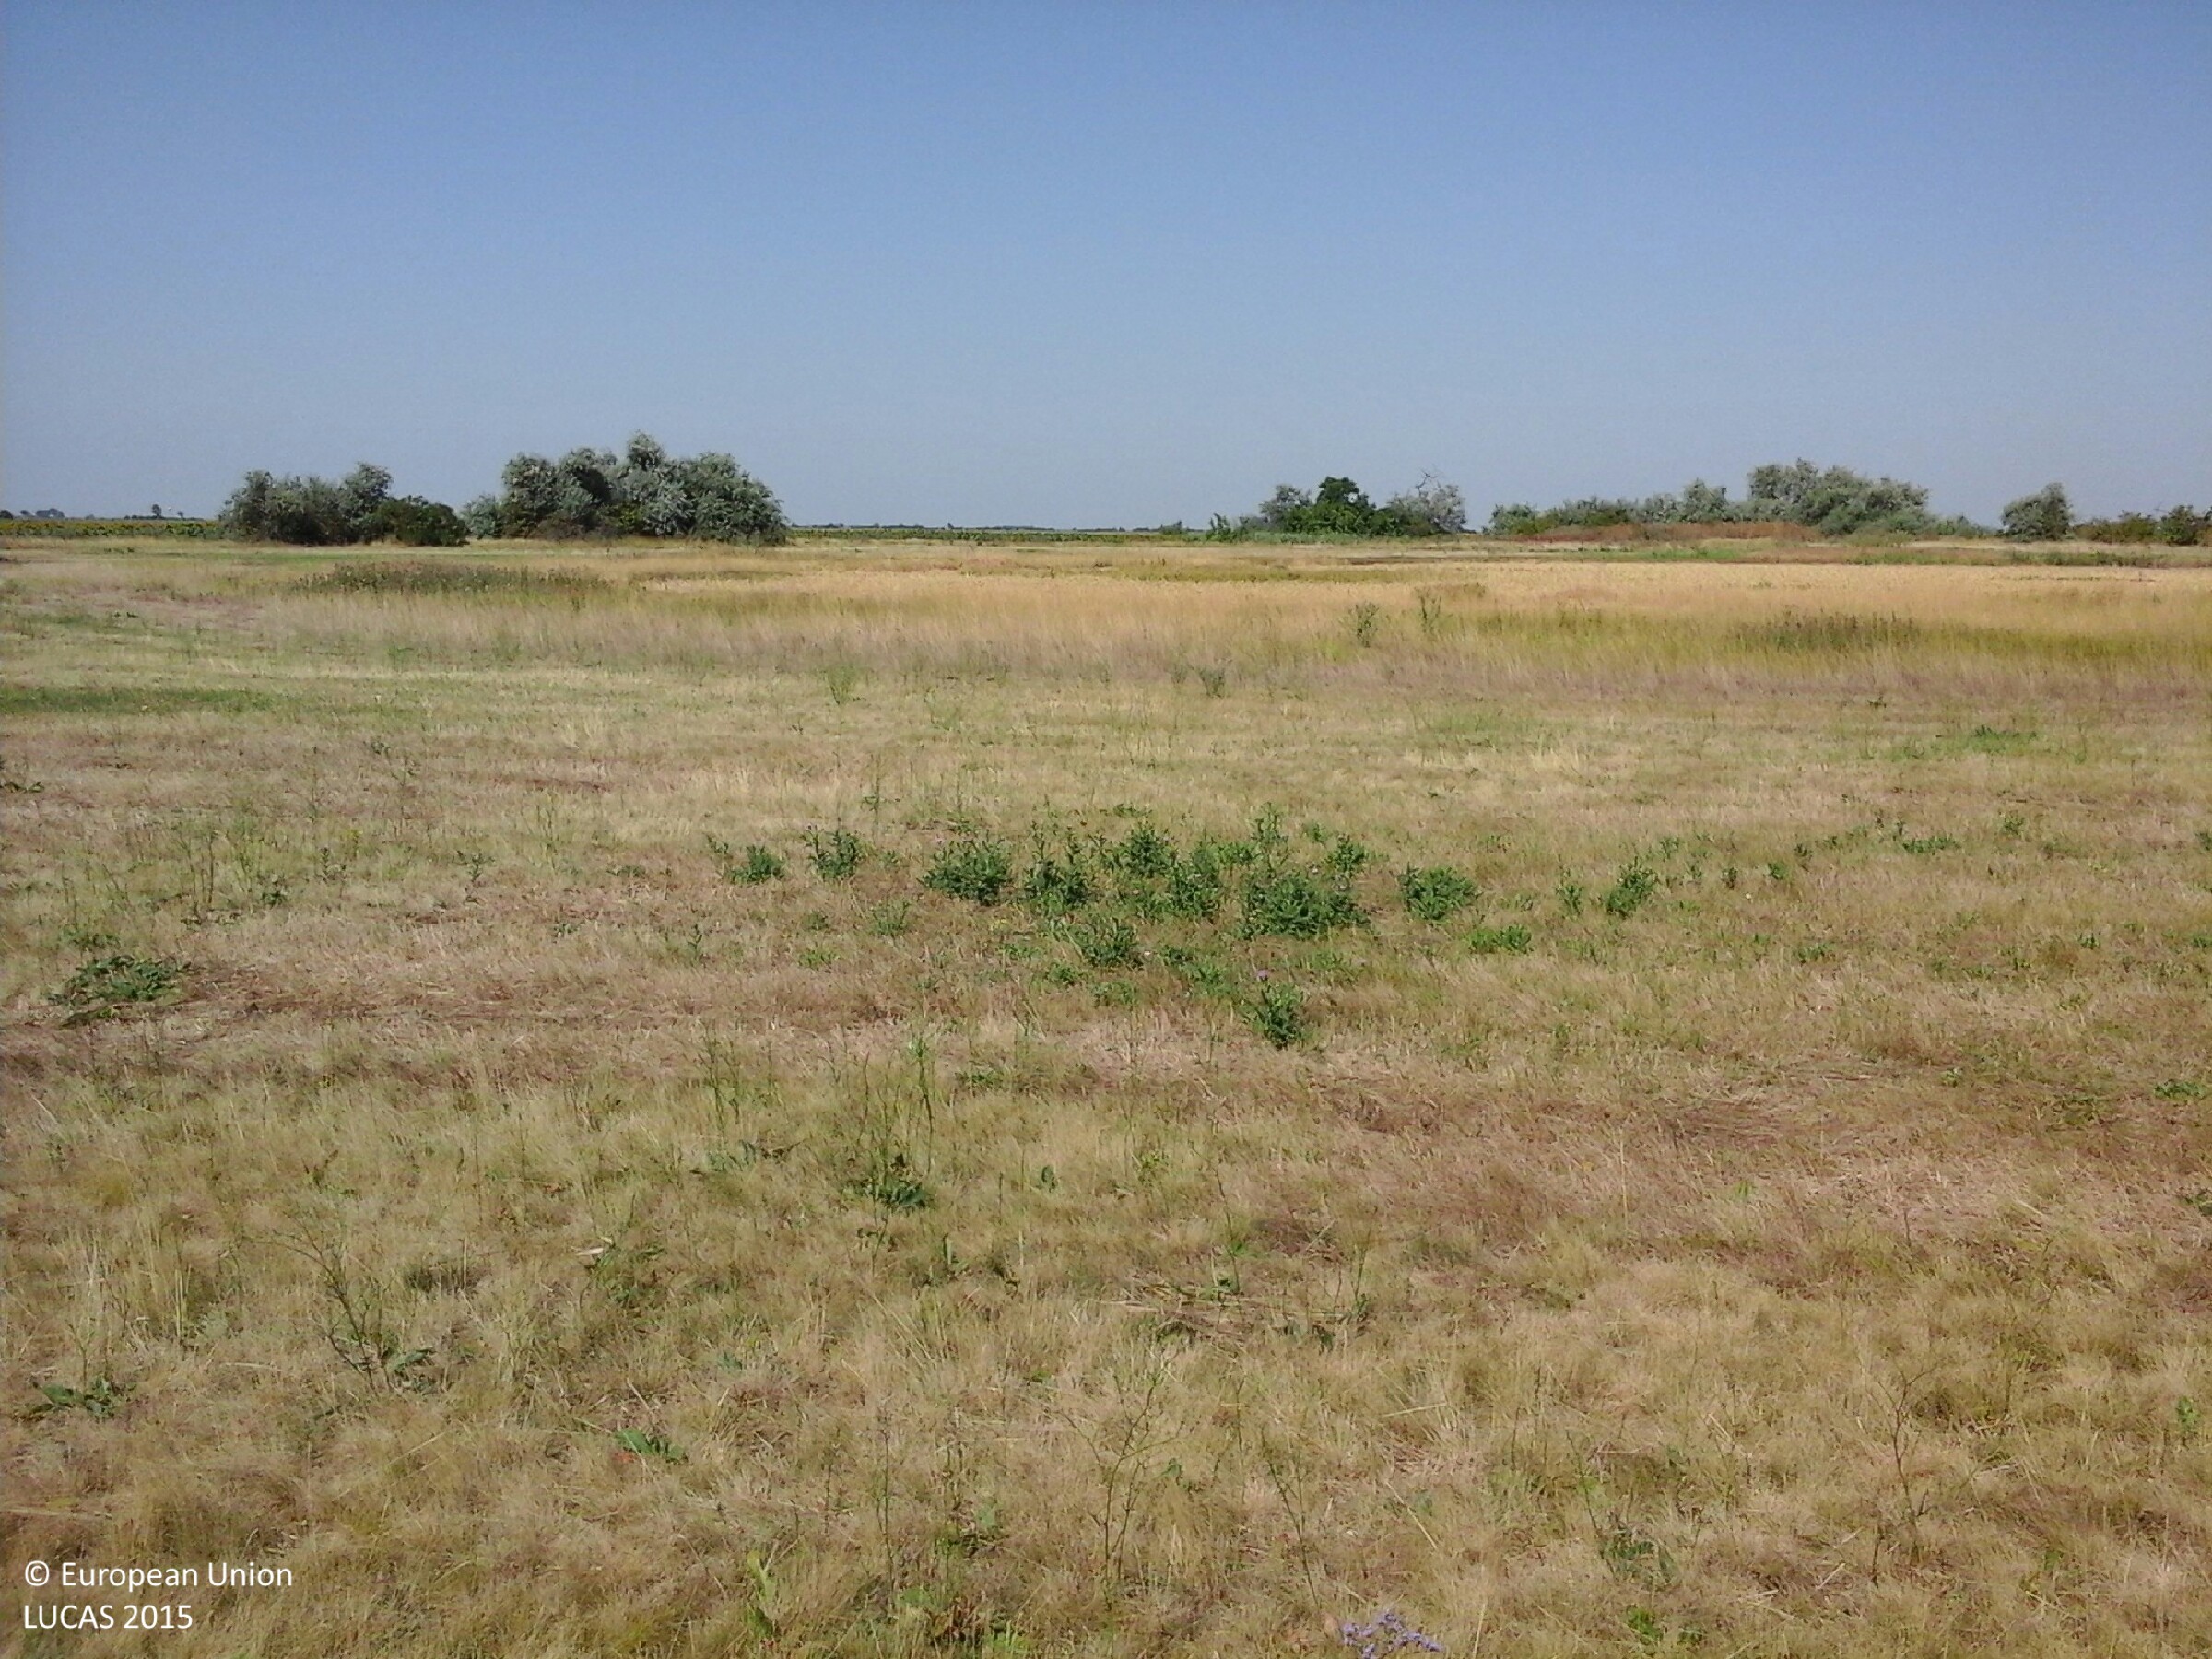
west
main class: Grassland
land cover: Grassland without tree/shrub cover
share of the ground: > 75 %
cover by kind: herbaceous plants 100 %
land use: Agriculture (excluding fallow land and kitchen gardens)
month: July
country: HU
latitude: 47.5888
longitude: 20.5504
